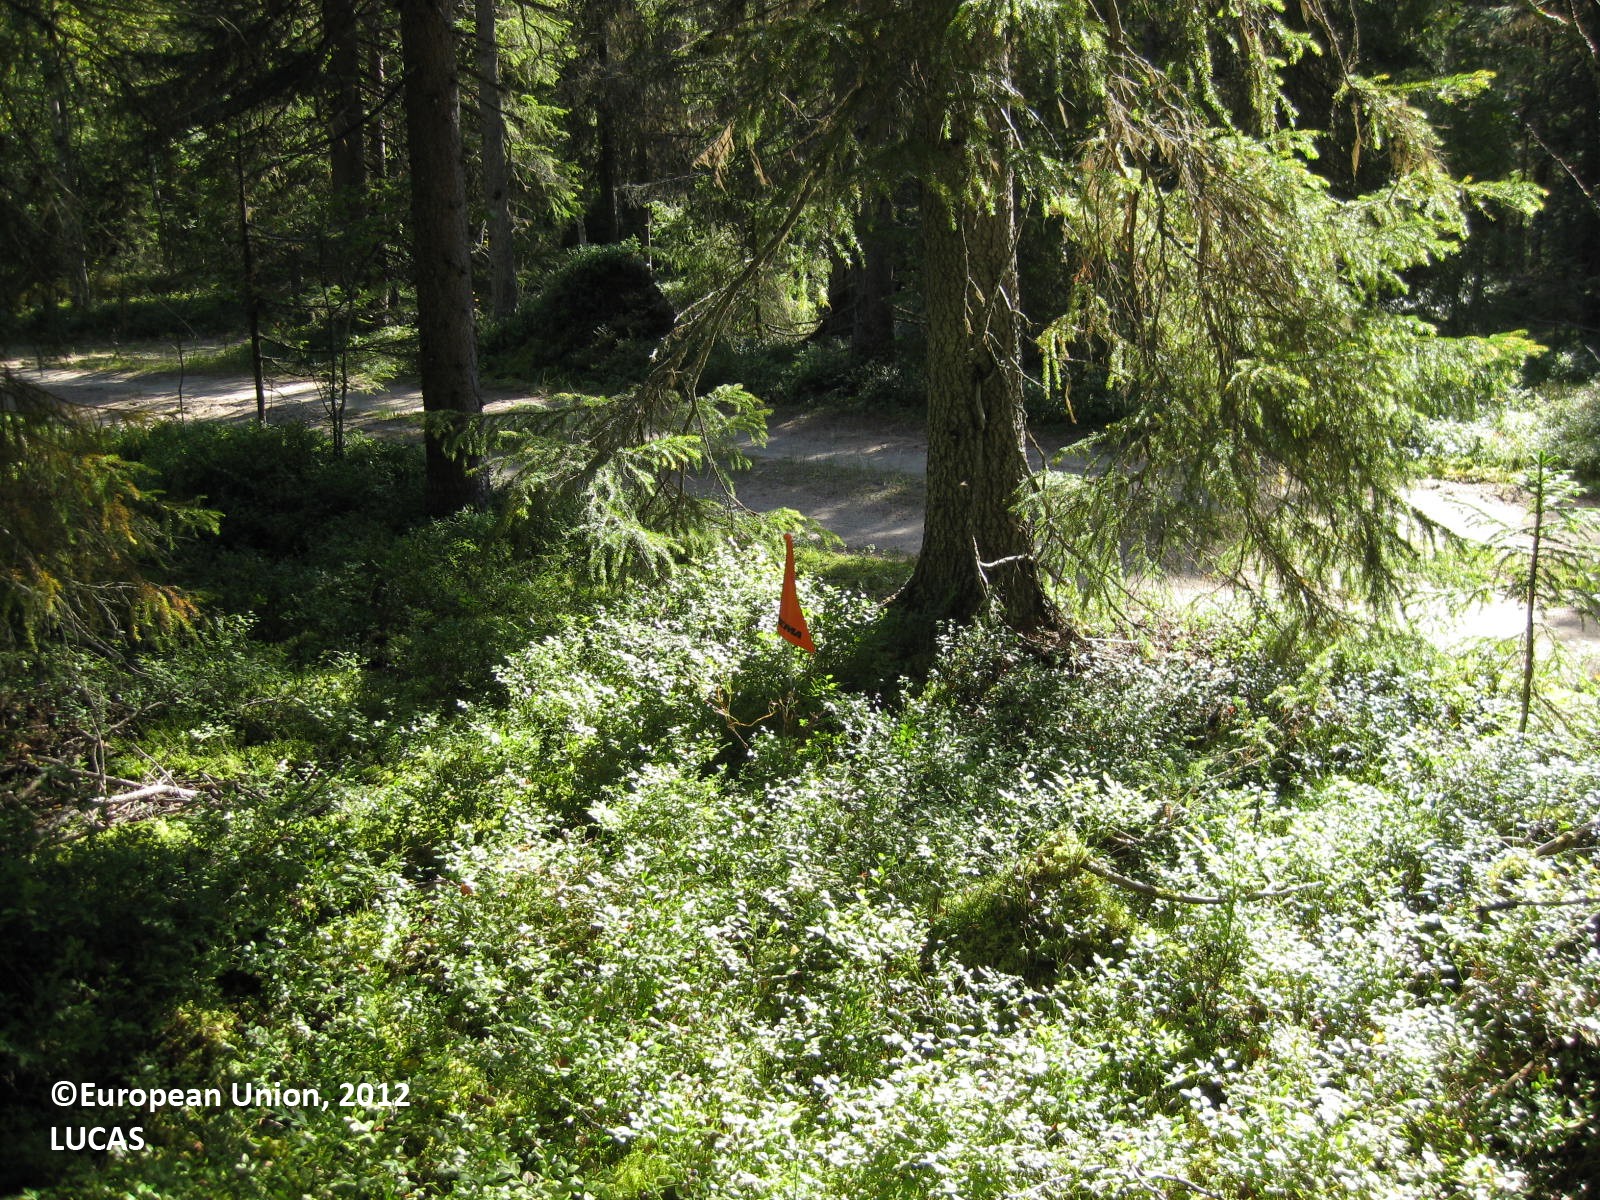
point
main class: Woodland
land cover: Other coniferous woodland
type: boreal forest
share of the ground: 50 - 75 %
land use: Forestry
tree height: > 5 m
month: August
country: FI
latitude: 66.0612
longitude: 29.7913
